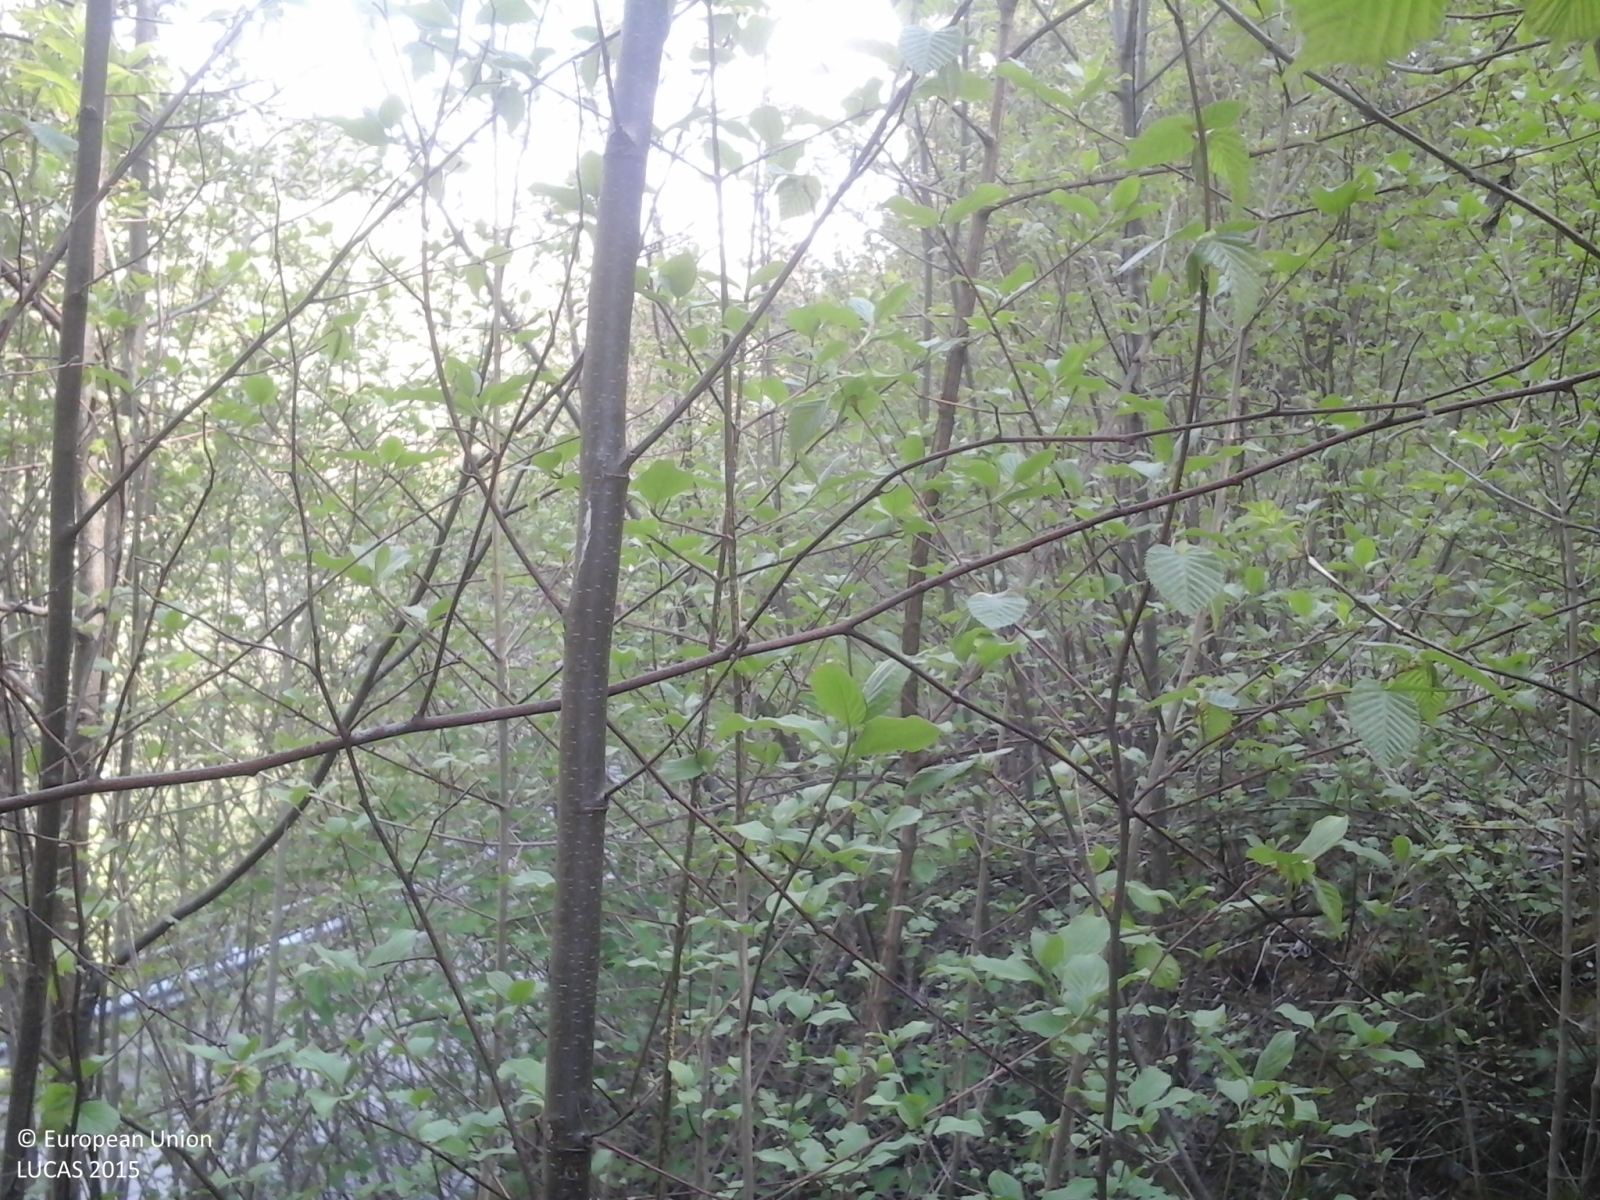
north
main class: Woodland
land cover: Broadleaved woodland
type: thermophilous deciduous forest
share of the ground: > 75 %
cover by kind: broadleaved forest trees 90 %, coniferous forest trees 10 %
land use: Forestry
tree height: > 5 m
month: April
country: IT
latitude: 46.3638
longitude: 11.0774
